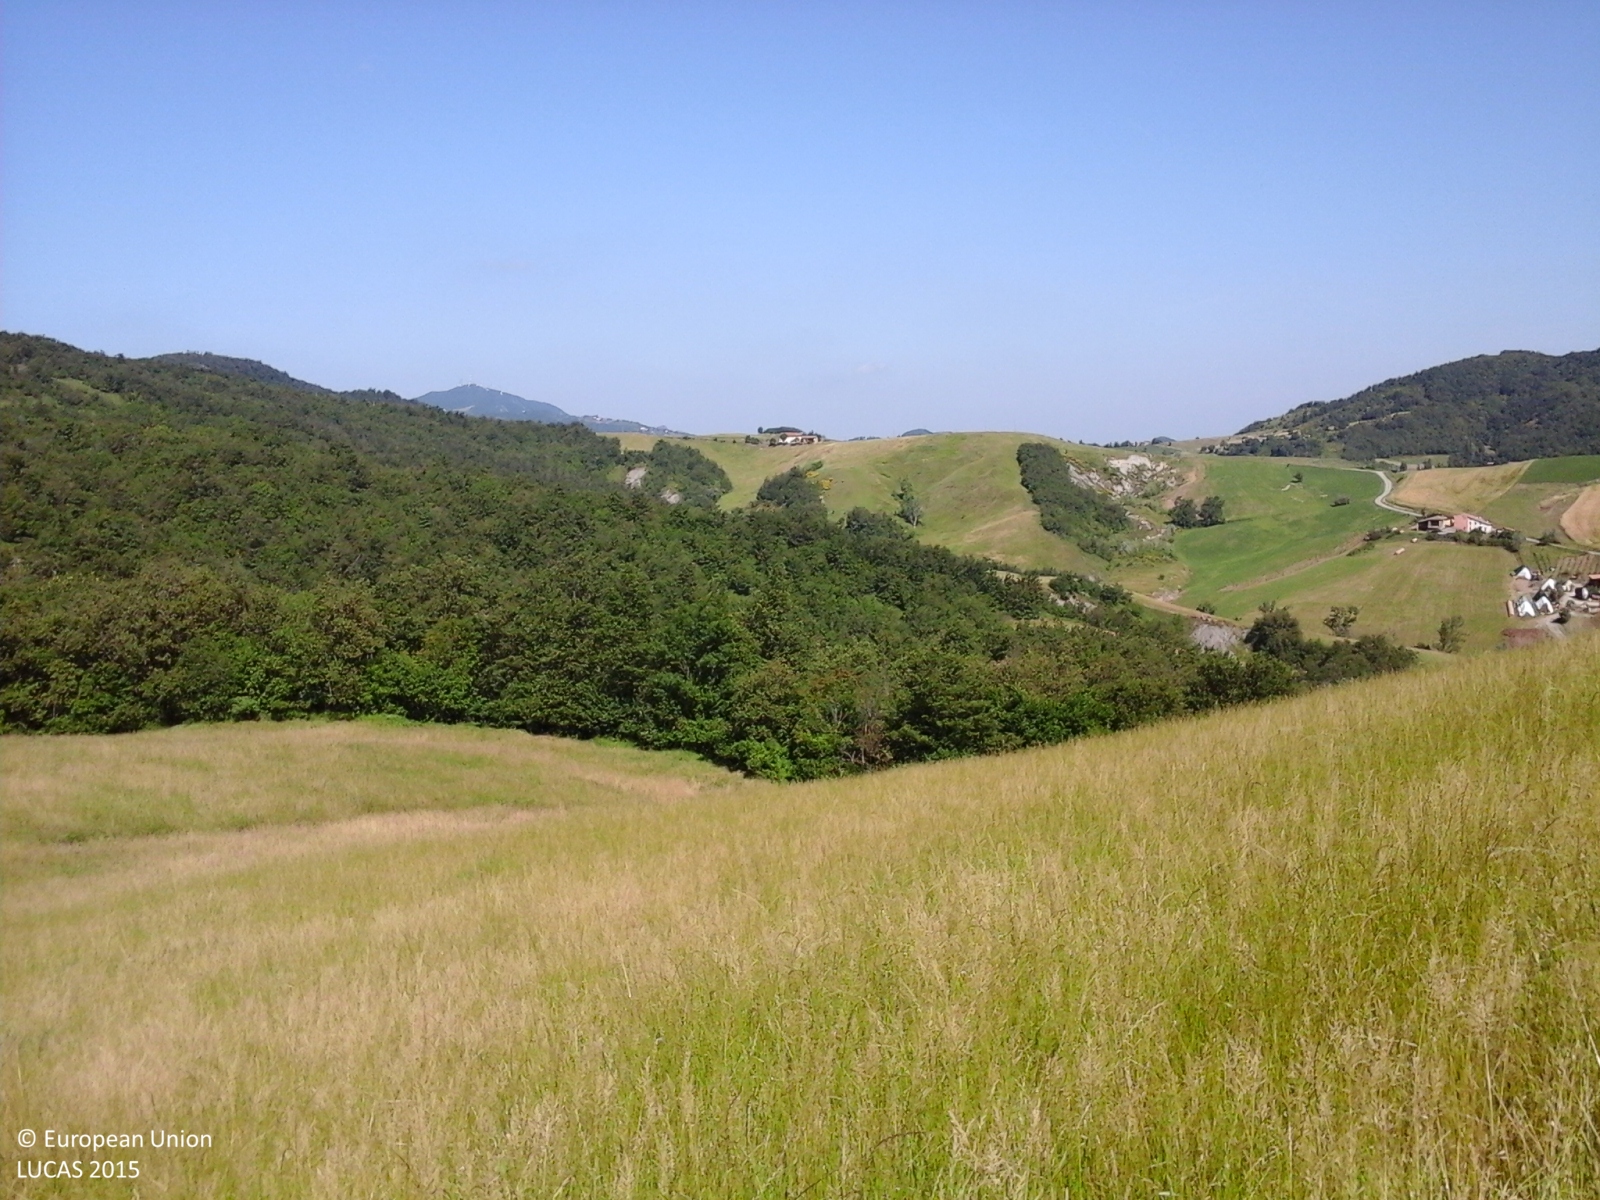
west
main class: Grassland
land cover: Grassland without tree/shrub cover
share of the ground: > 75 %
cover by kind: herbaceous plants 100 %
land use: Agriculture (excluding fallow land and kitchen gardens)
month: May
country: IT
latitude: 44.7293
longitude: 10.0126
